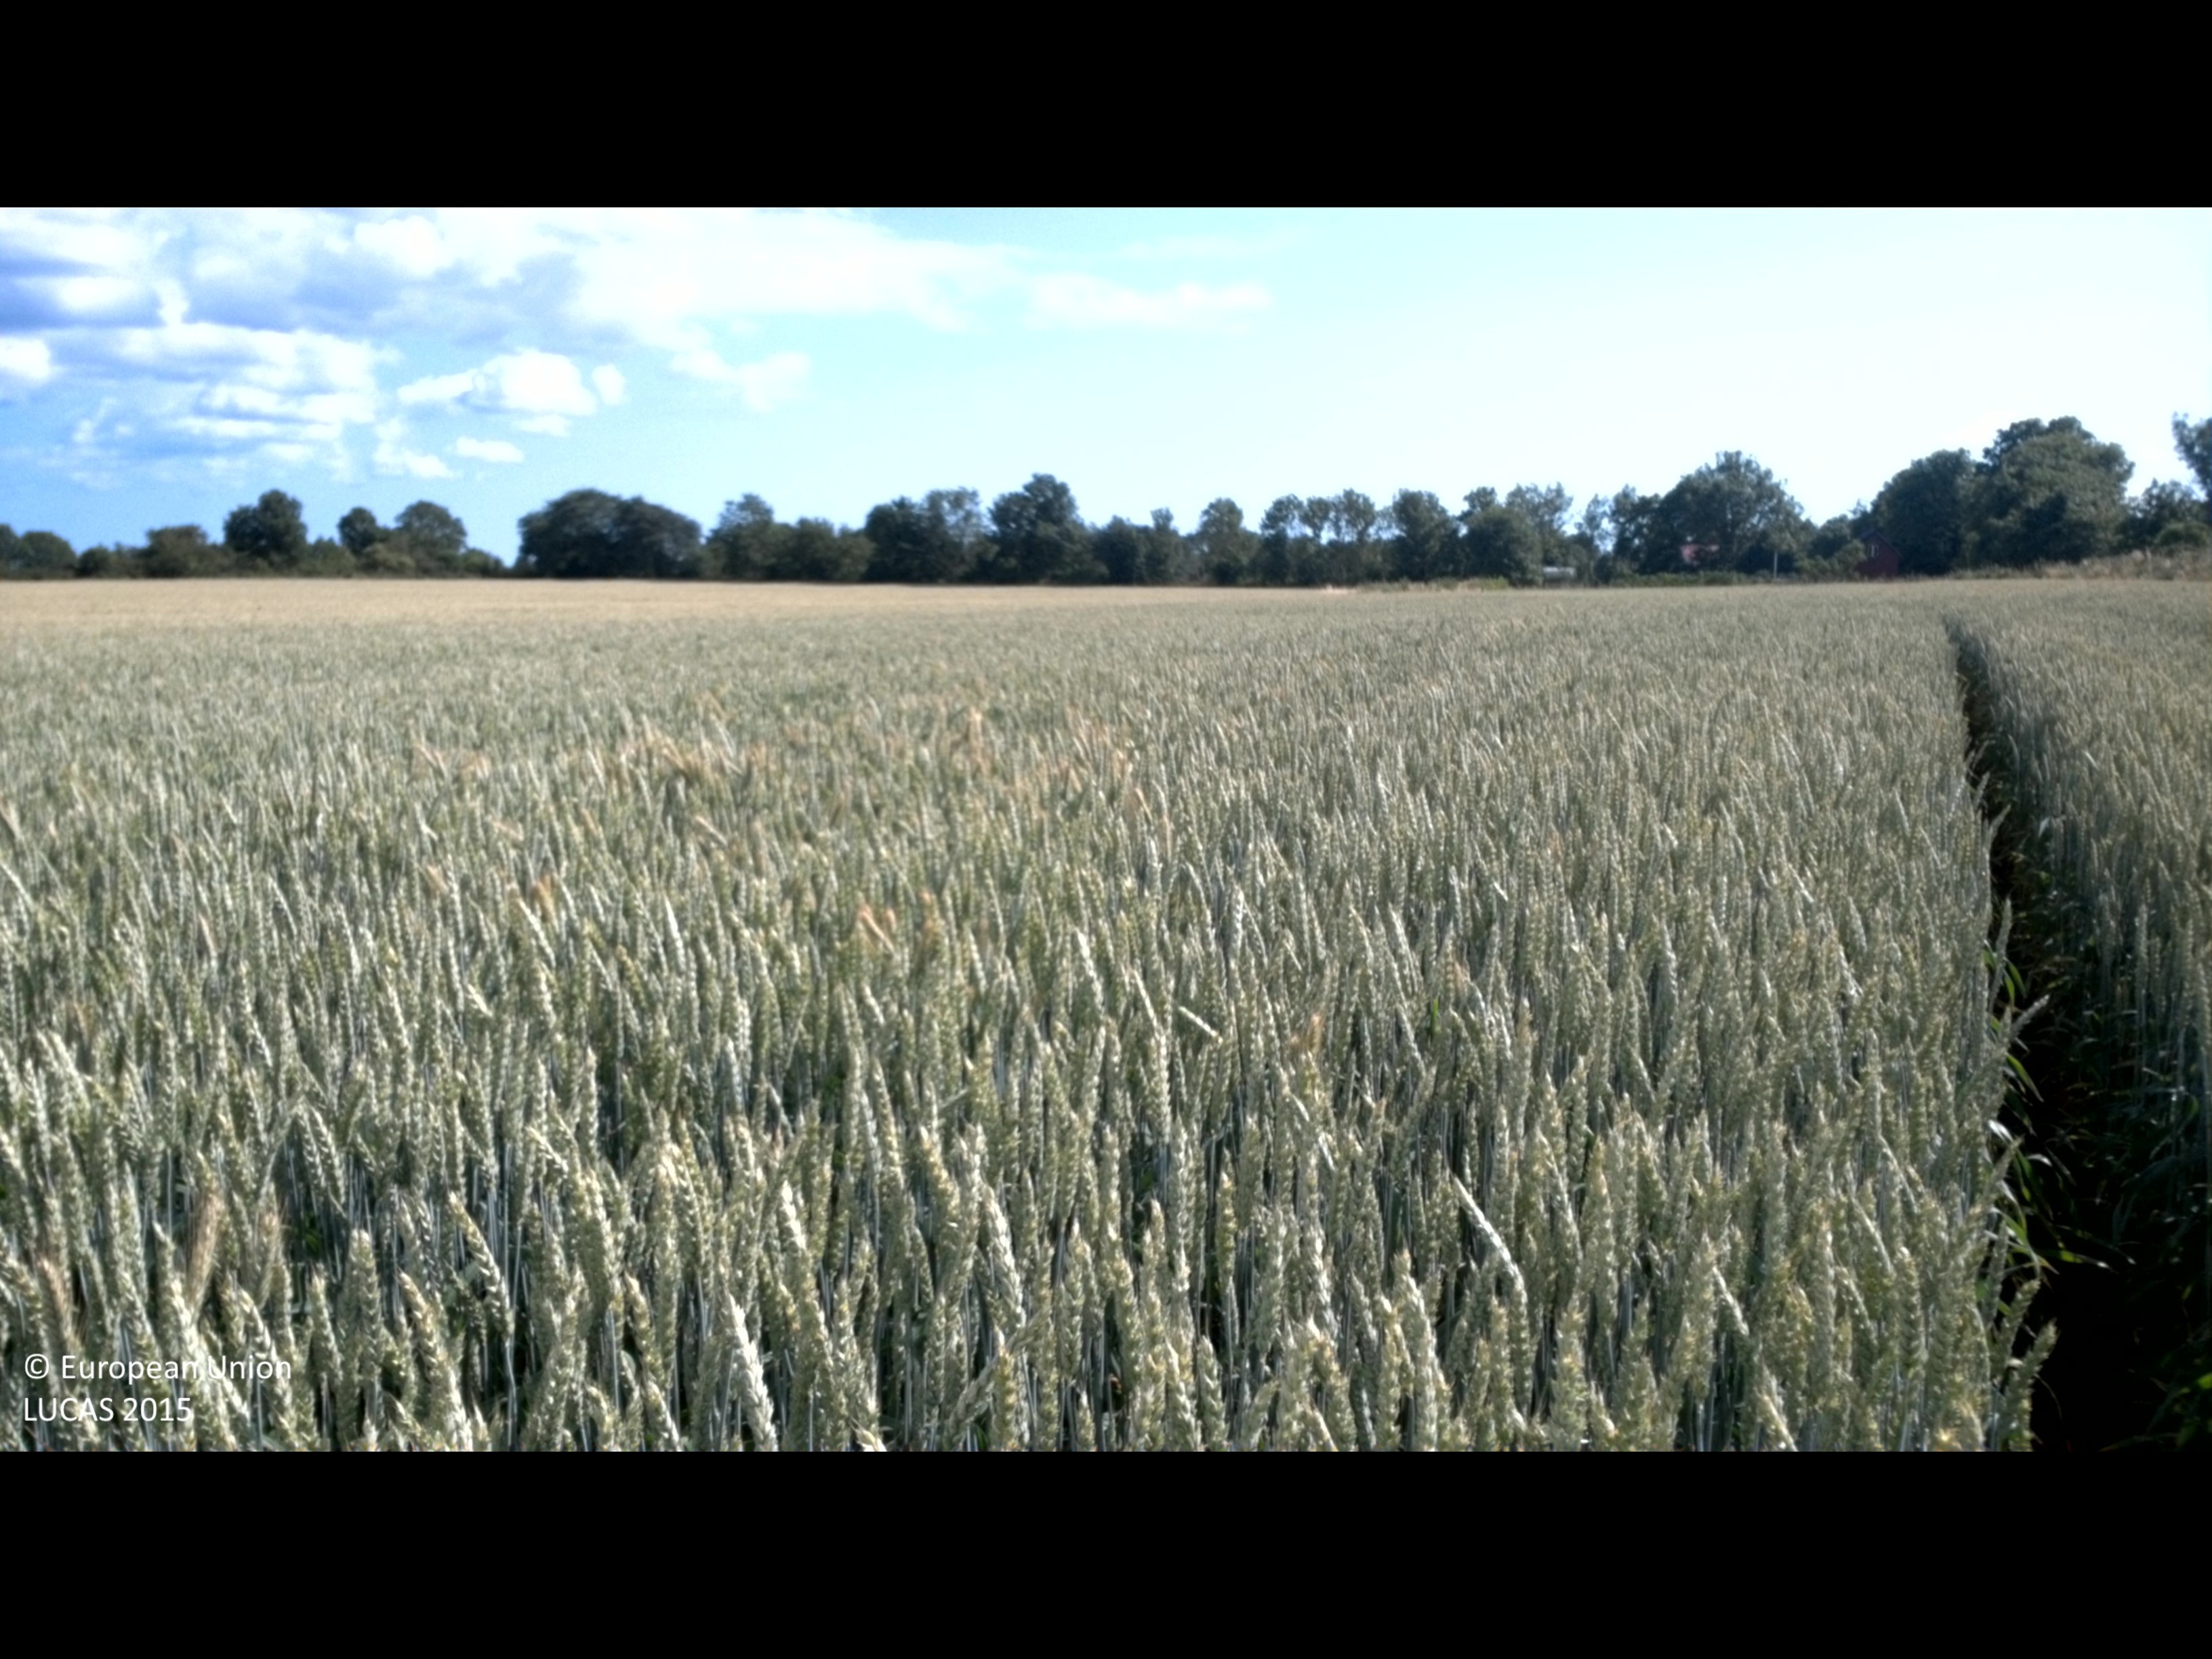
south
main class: Cropland
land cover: Common wheat
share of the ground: > 75 %
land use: Agriculture (excluding fallow land and kitchen gardens)
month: July
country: SE
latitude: 56.5841
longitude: 16.4652
